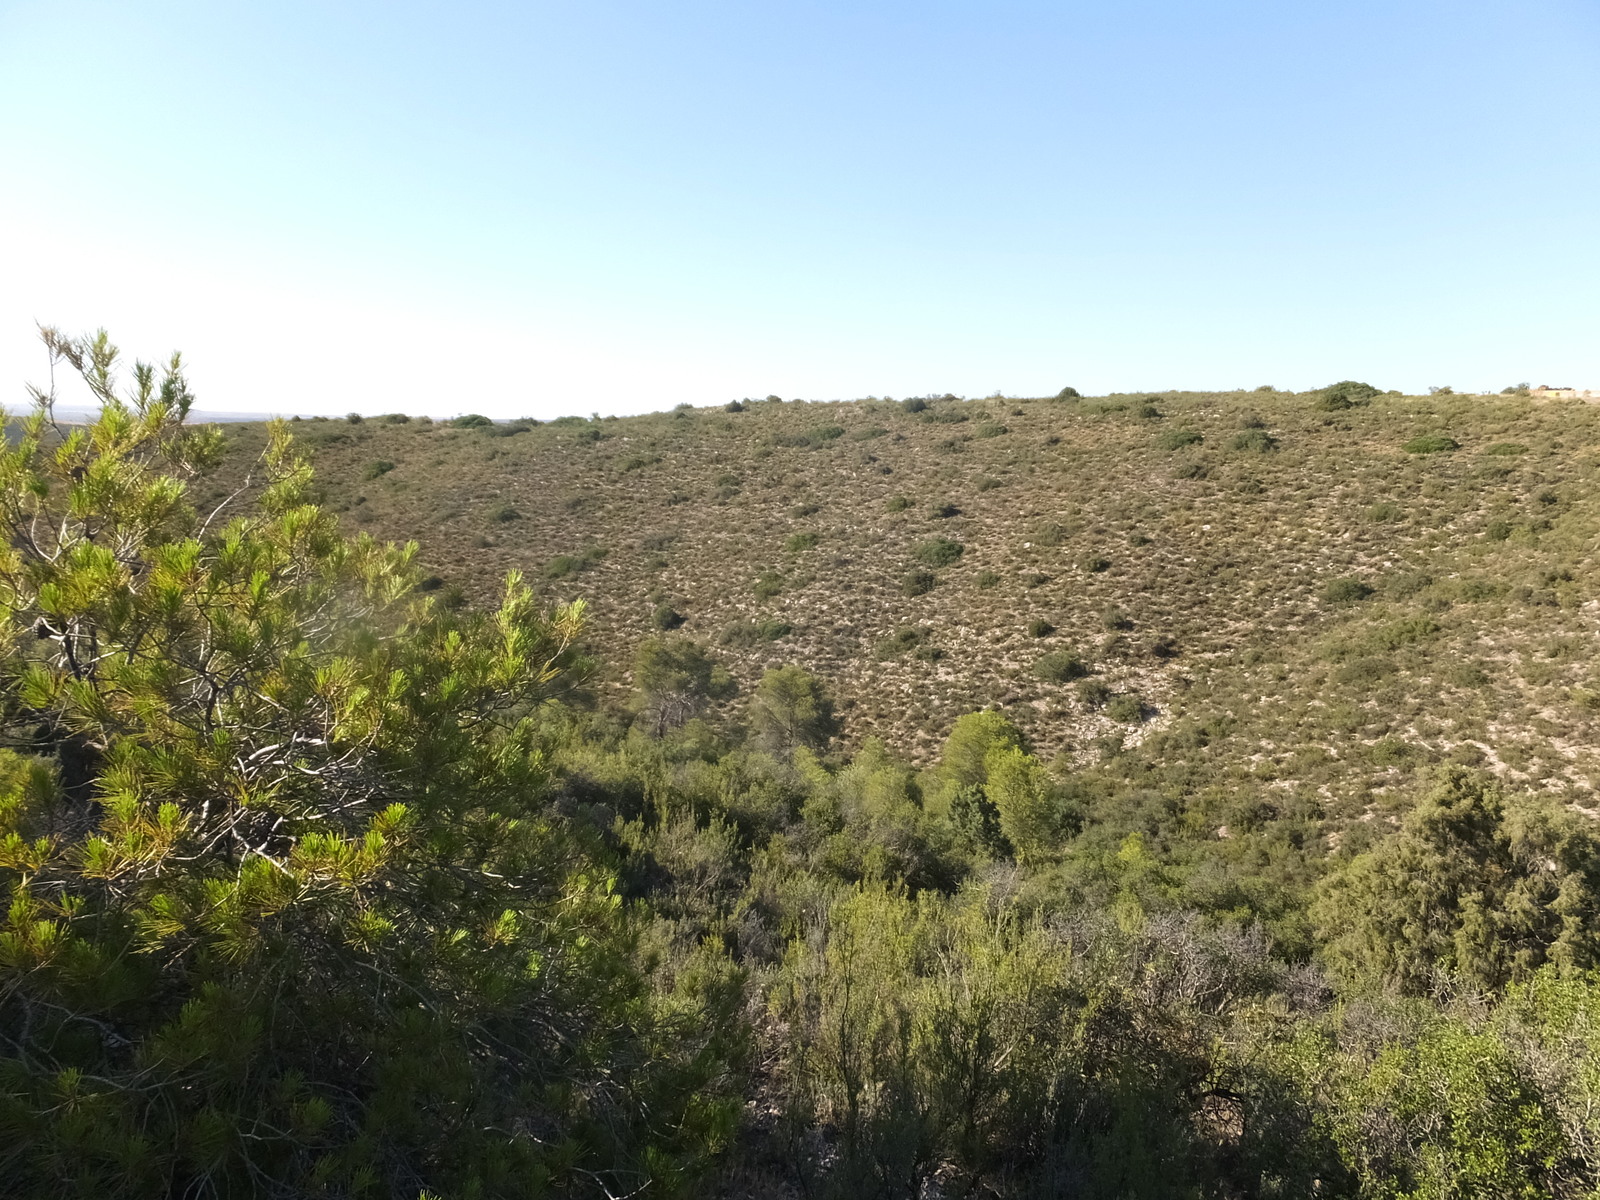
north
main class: Shrubland
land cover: Shrubland with sparse tree cover
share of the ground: > 75 %
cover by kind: shrubs 75 %, herbaceous plants 20 %, coniferous forest trees 5 %
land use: Semi-natural and natural areas not in use
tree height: < 5 m
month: July
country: ES
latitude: 41.4128
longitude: 0.1891
